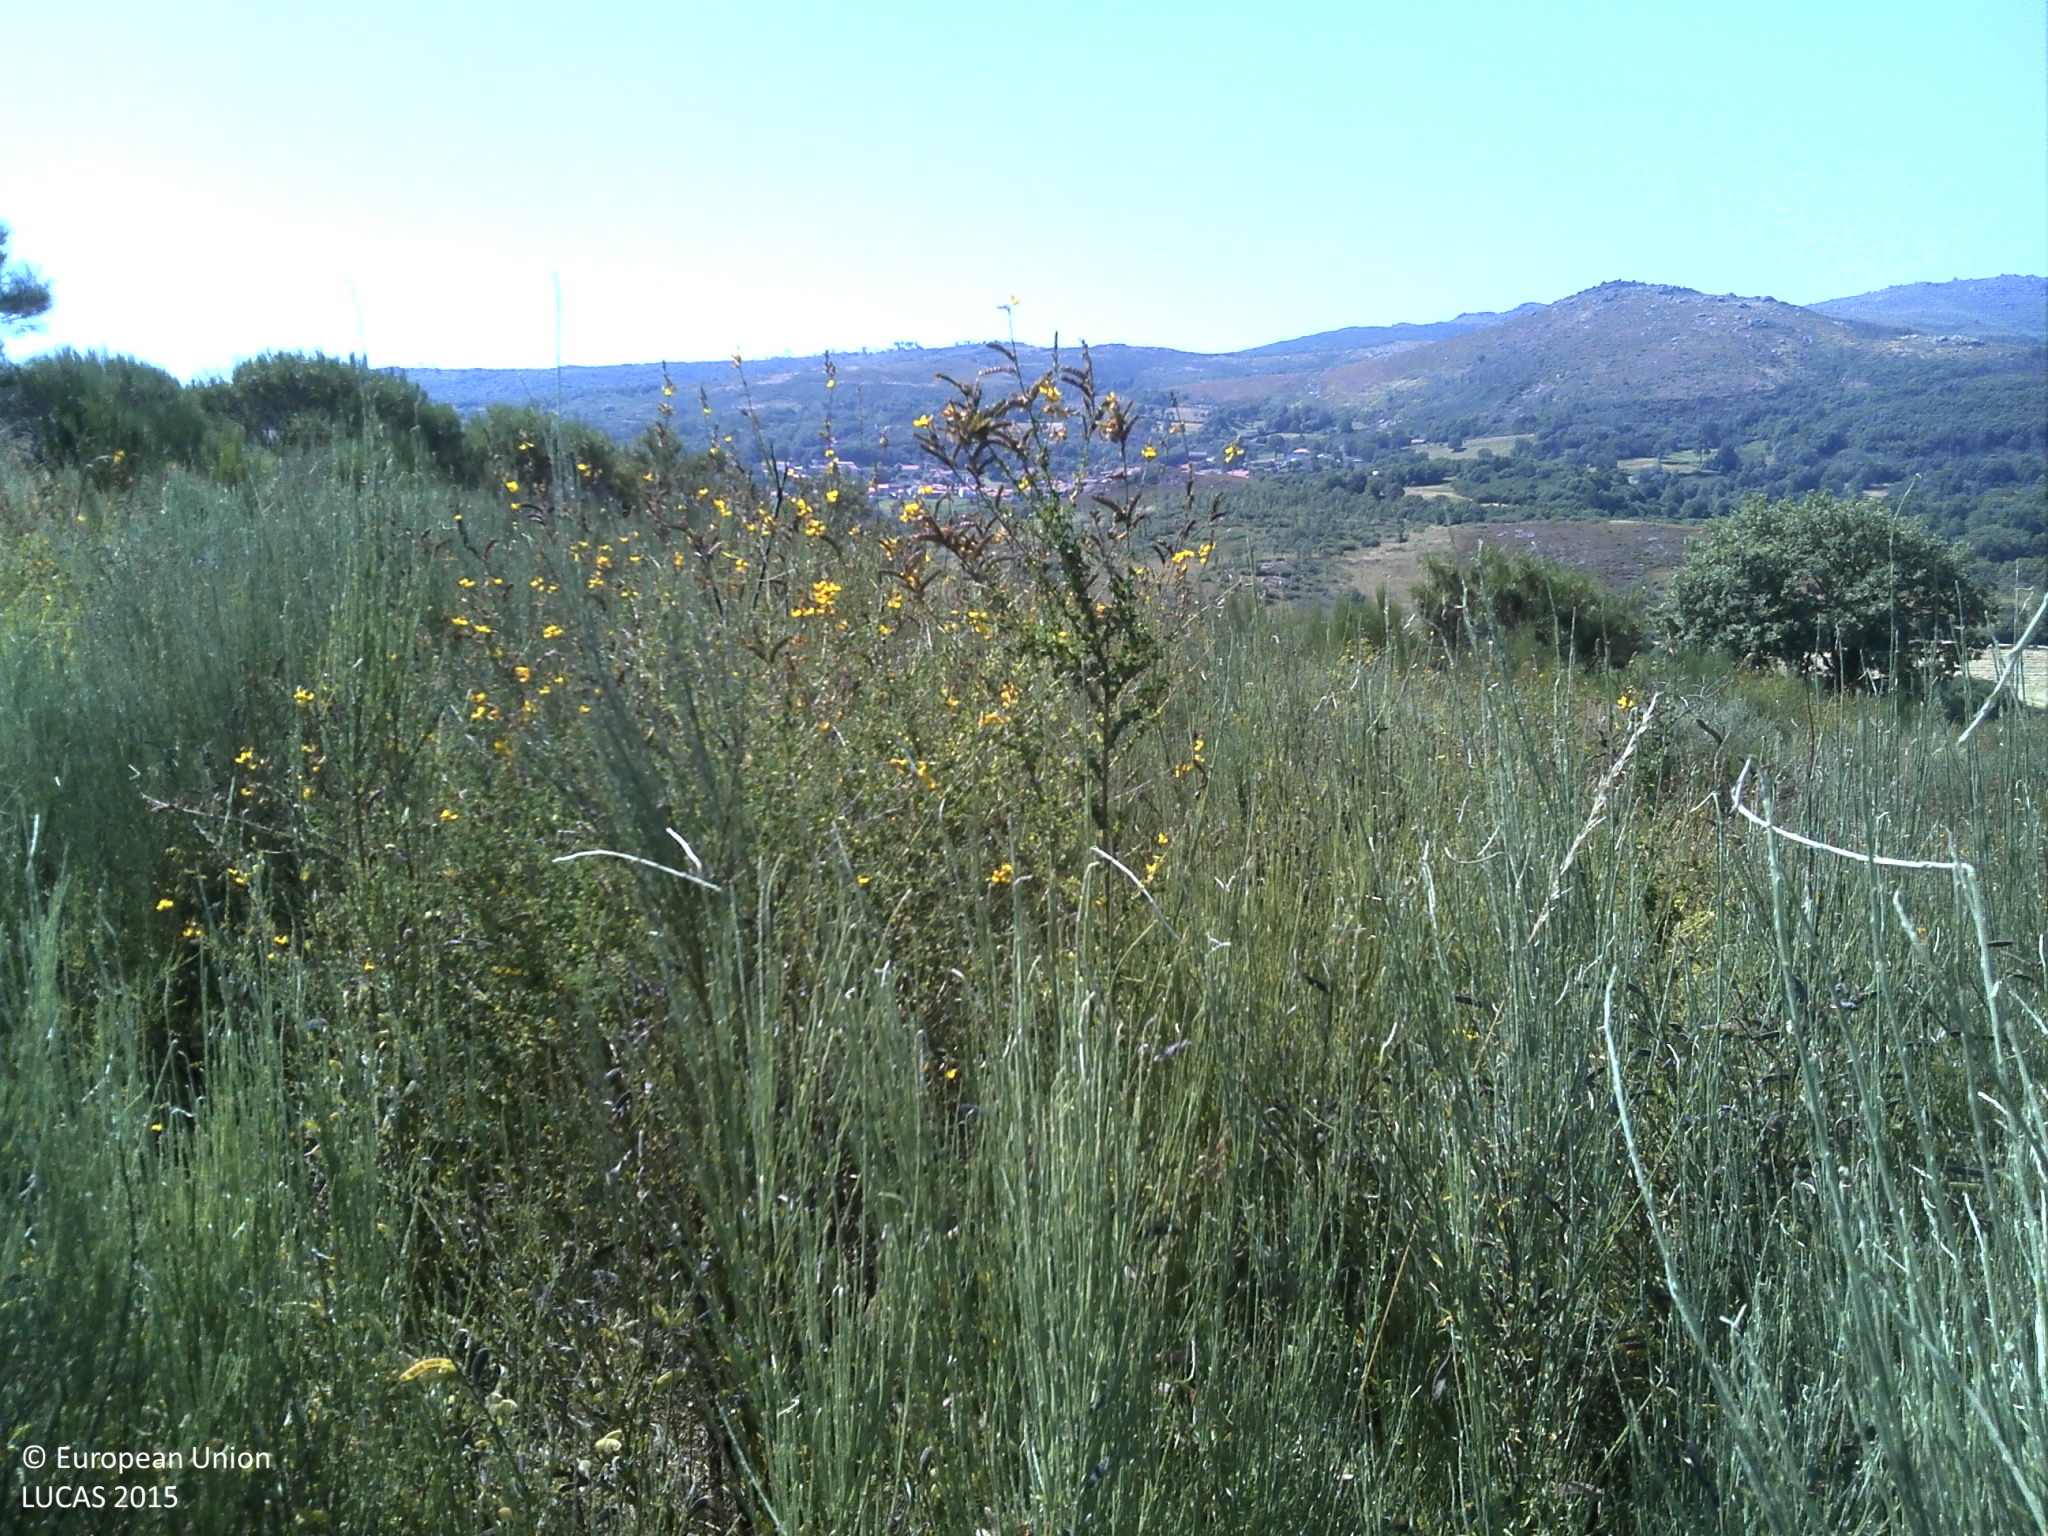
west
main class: Shrubland
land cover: Shrubland without tree cover
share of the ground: > 75 %
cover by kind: shrubs 90 %, herbaceous plants 5 %, unconsolidated bare surface 5 %
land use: Agriculture (excluding fallow land and kitchen gardens)
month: July
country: PT
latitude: 41.8101
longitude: -7.8480
